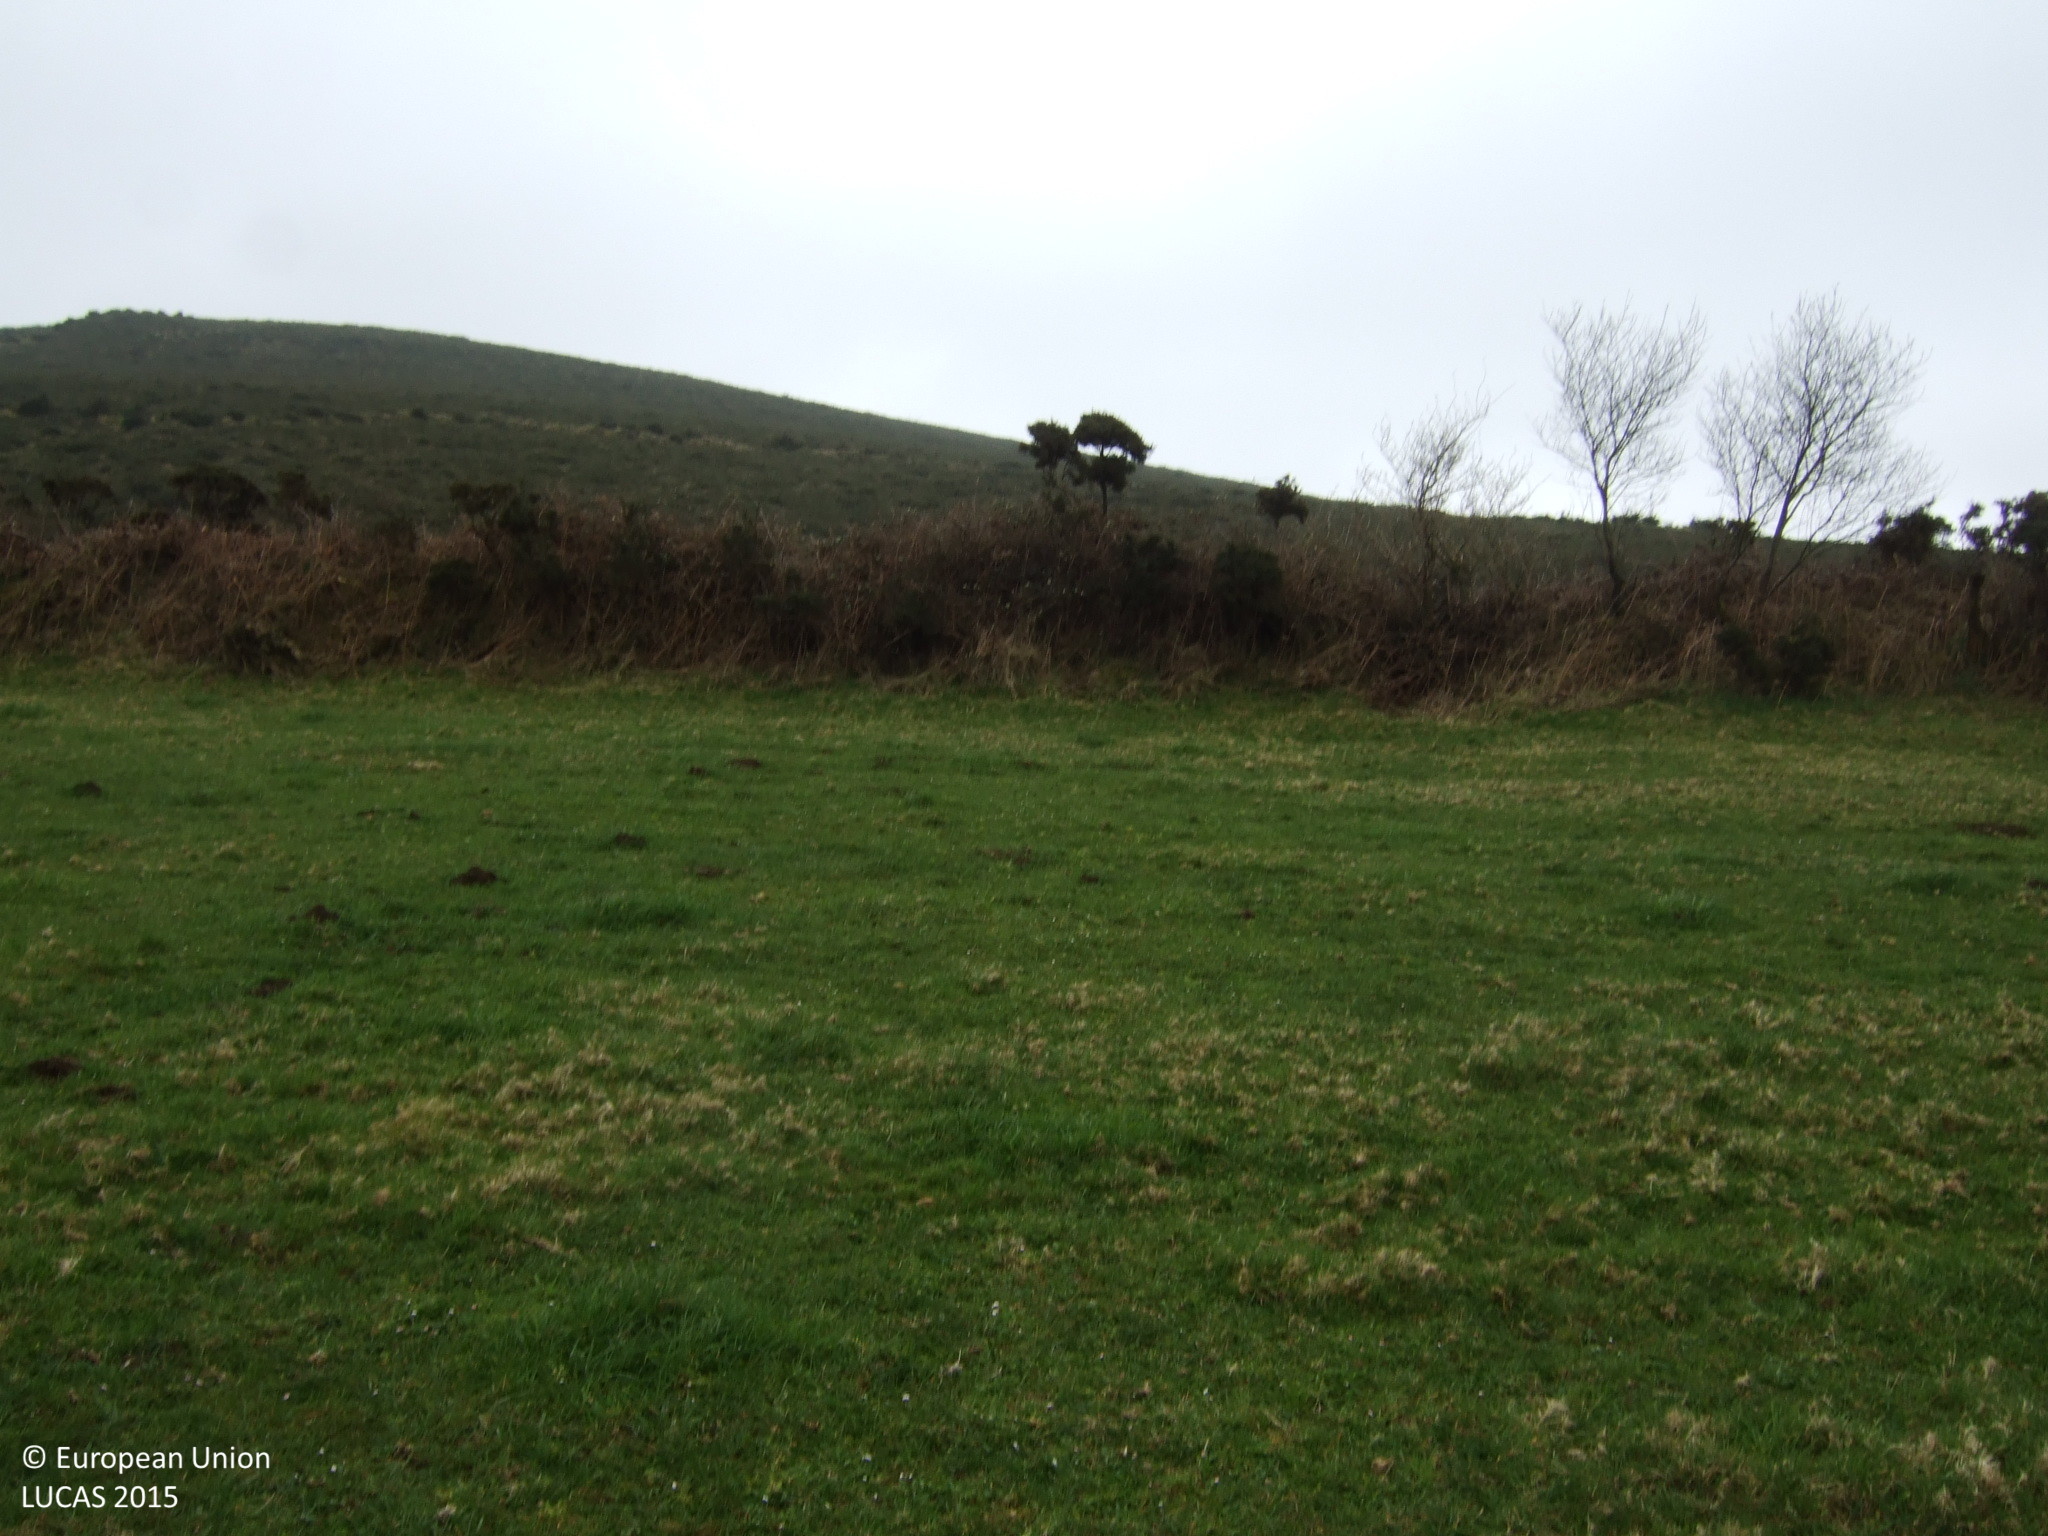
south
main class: Grassland
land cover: Grassland without tree/shrub cover
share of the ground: > 75 %
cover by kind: herbaceous plants 100 %
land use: Agriculture (excluding fallow land and kitchen gardens)
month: March
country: ES
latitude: 42.9673
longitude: -7.8753
